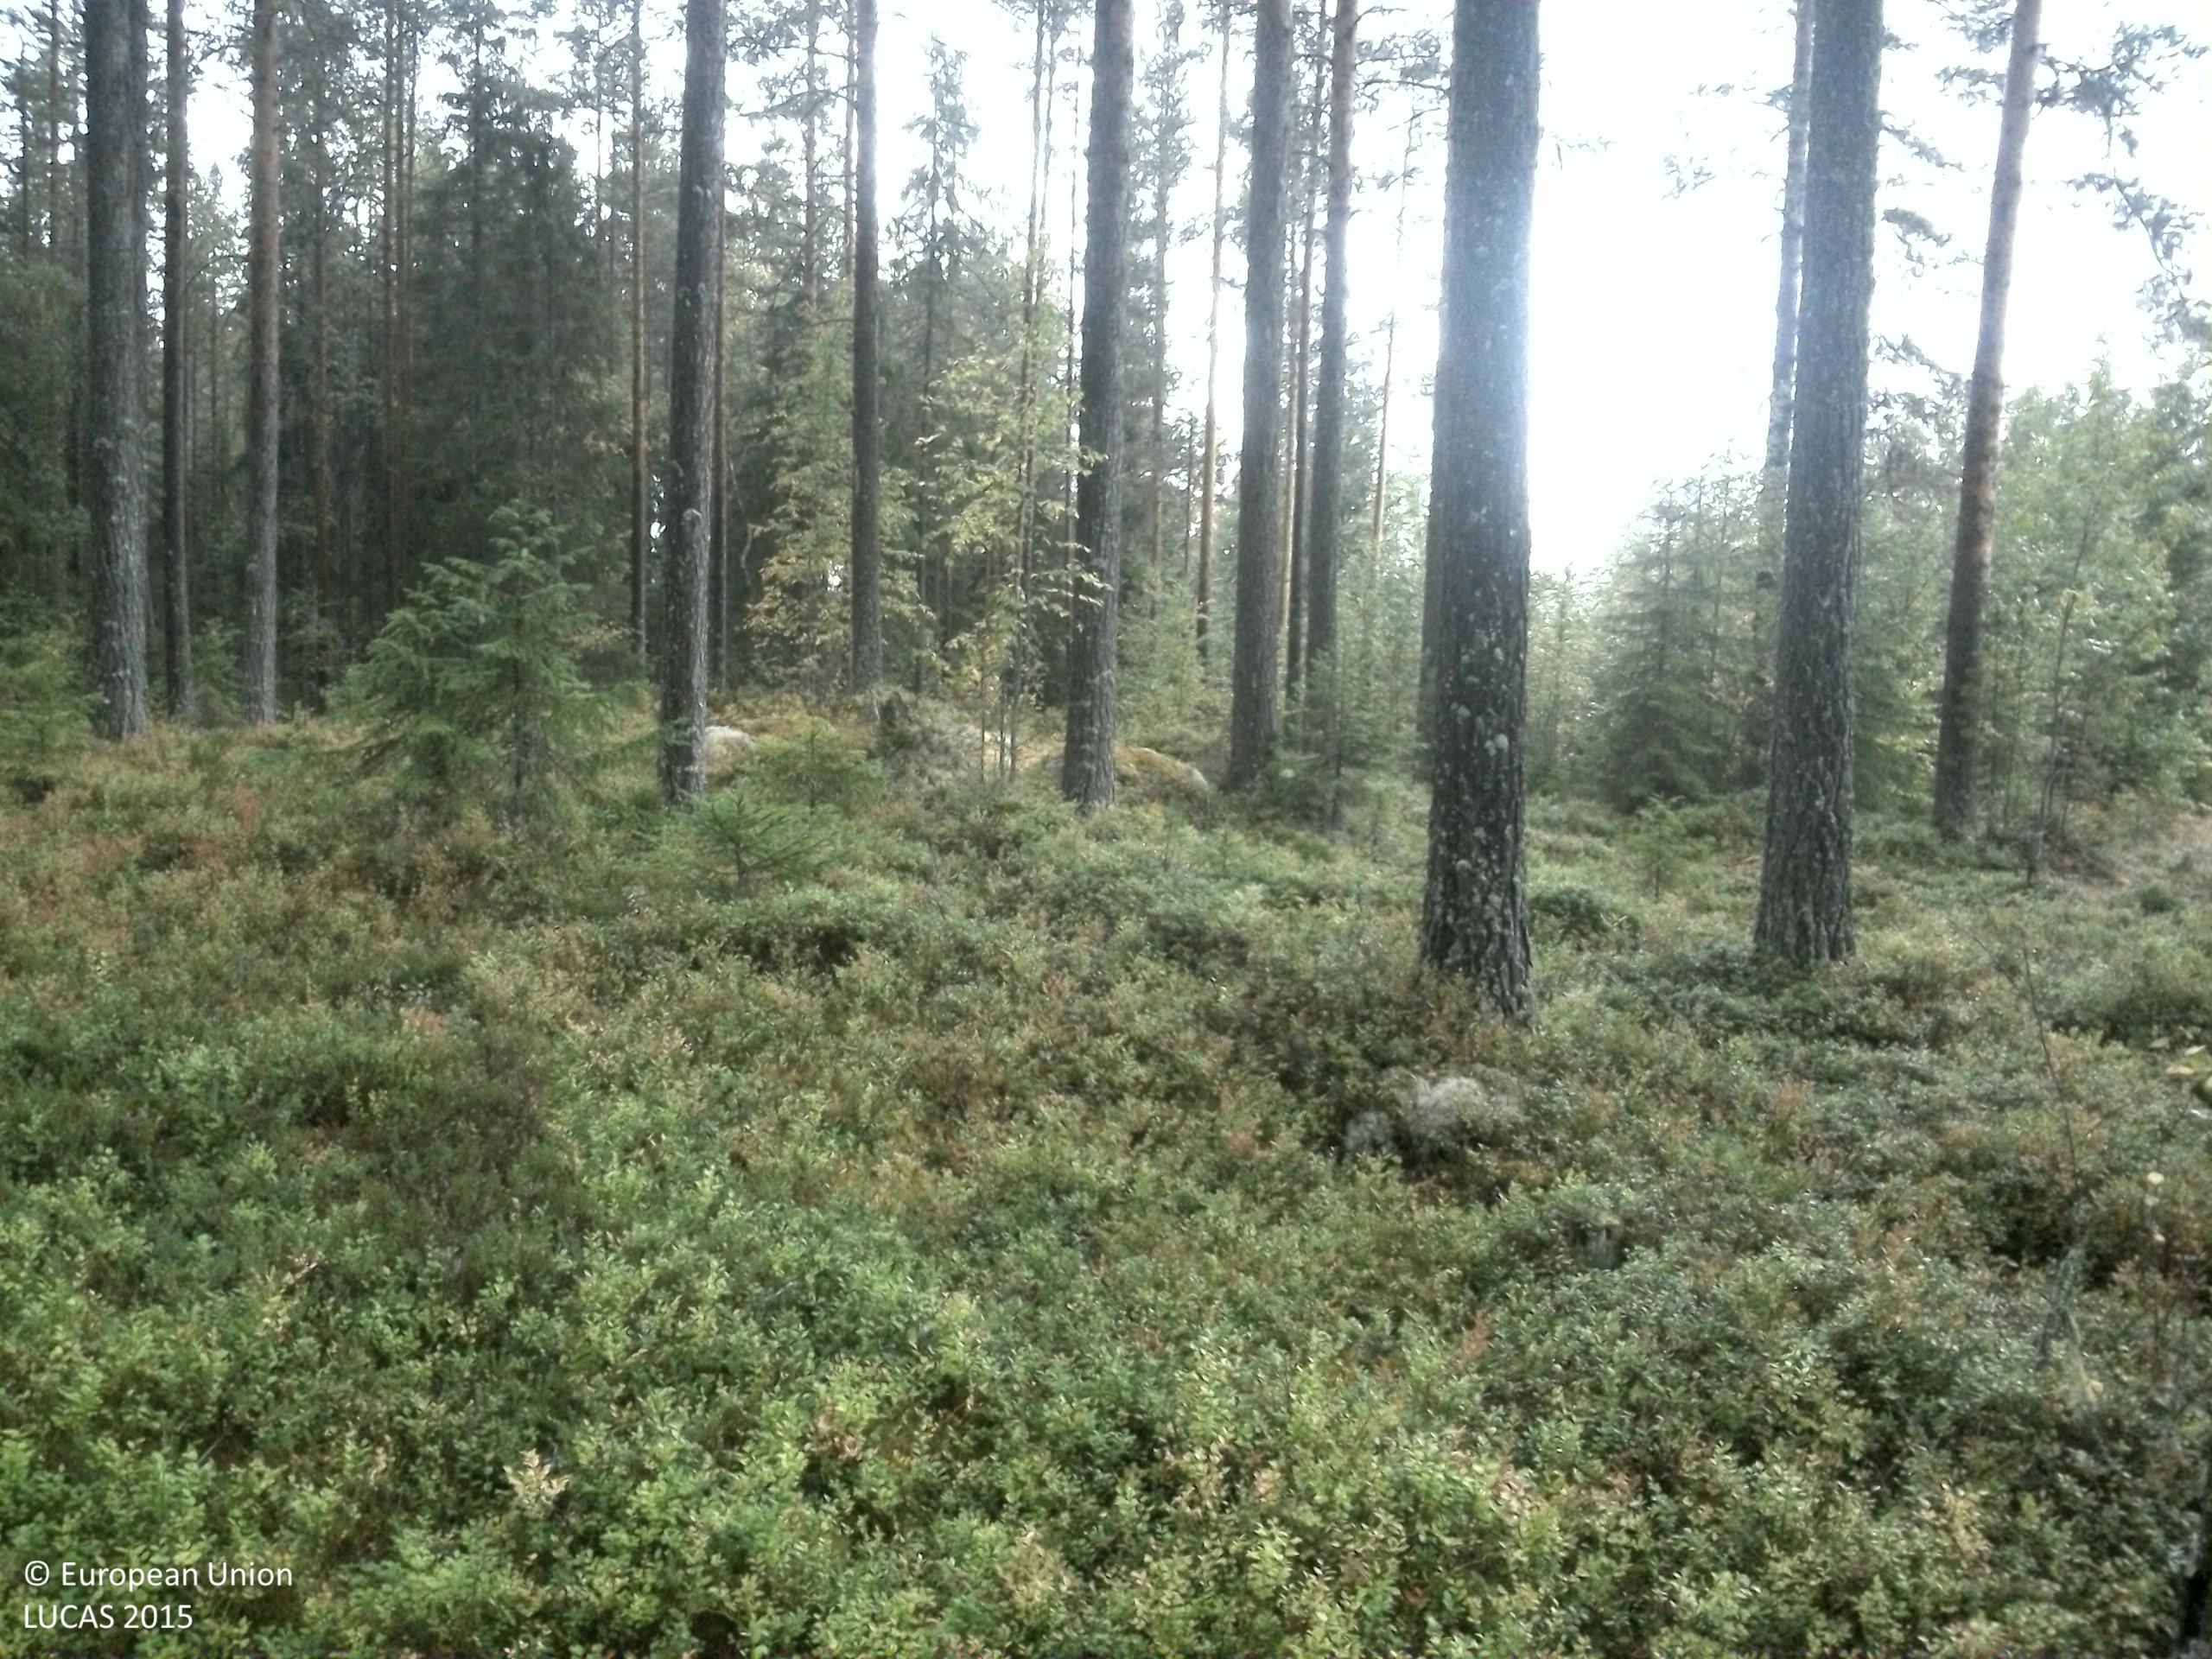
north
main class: Woodland
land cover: Pine dominated coniferous woodland
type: boreal forest
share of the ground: 50 - 75 %
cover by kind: coniferous forest trees 60 %, shrubs 40 %
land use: Forestry
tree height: > 5 m
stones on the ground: 10 - 25 %
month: September
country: SE
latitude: 61.6177
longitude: 15.2450
